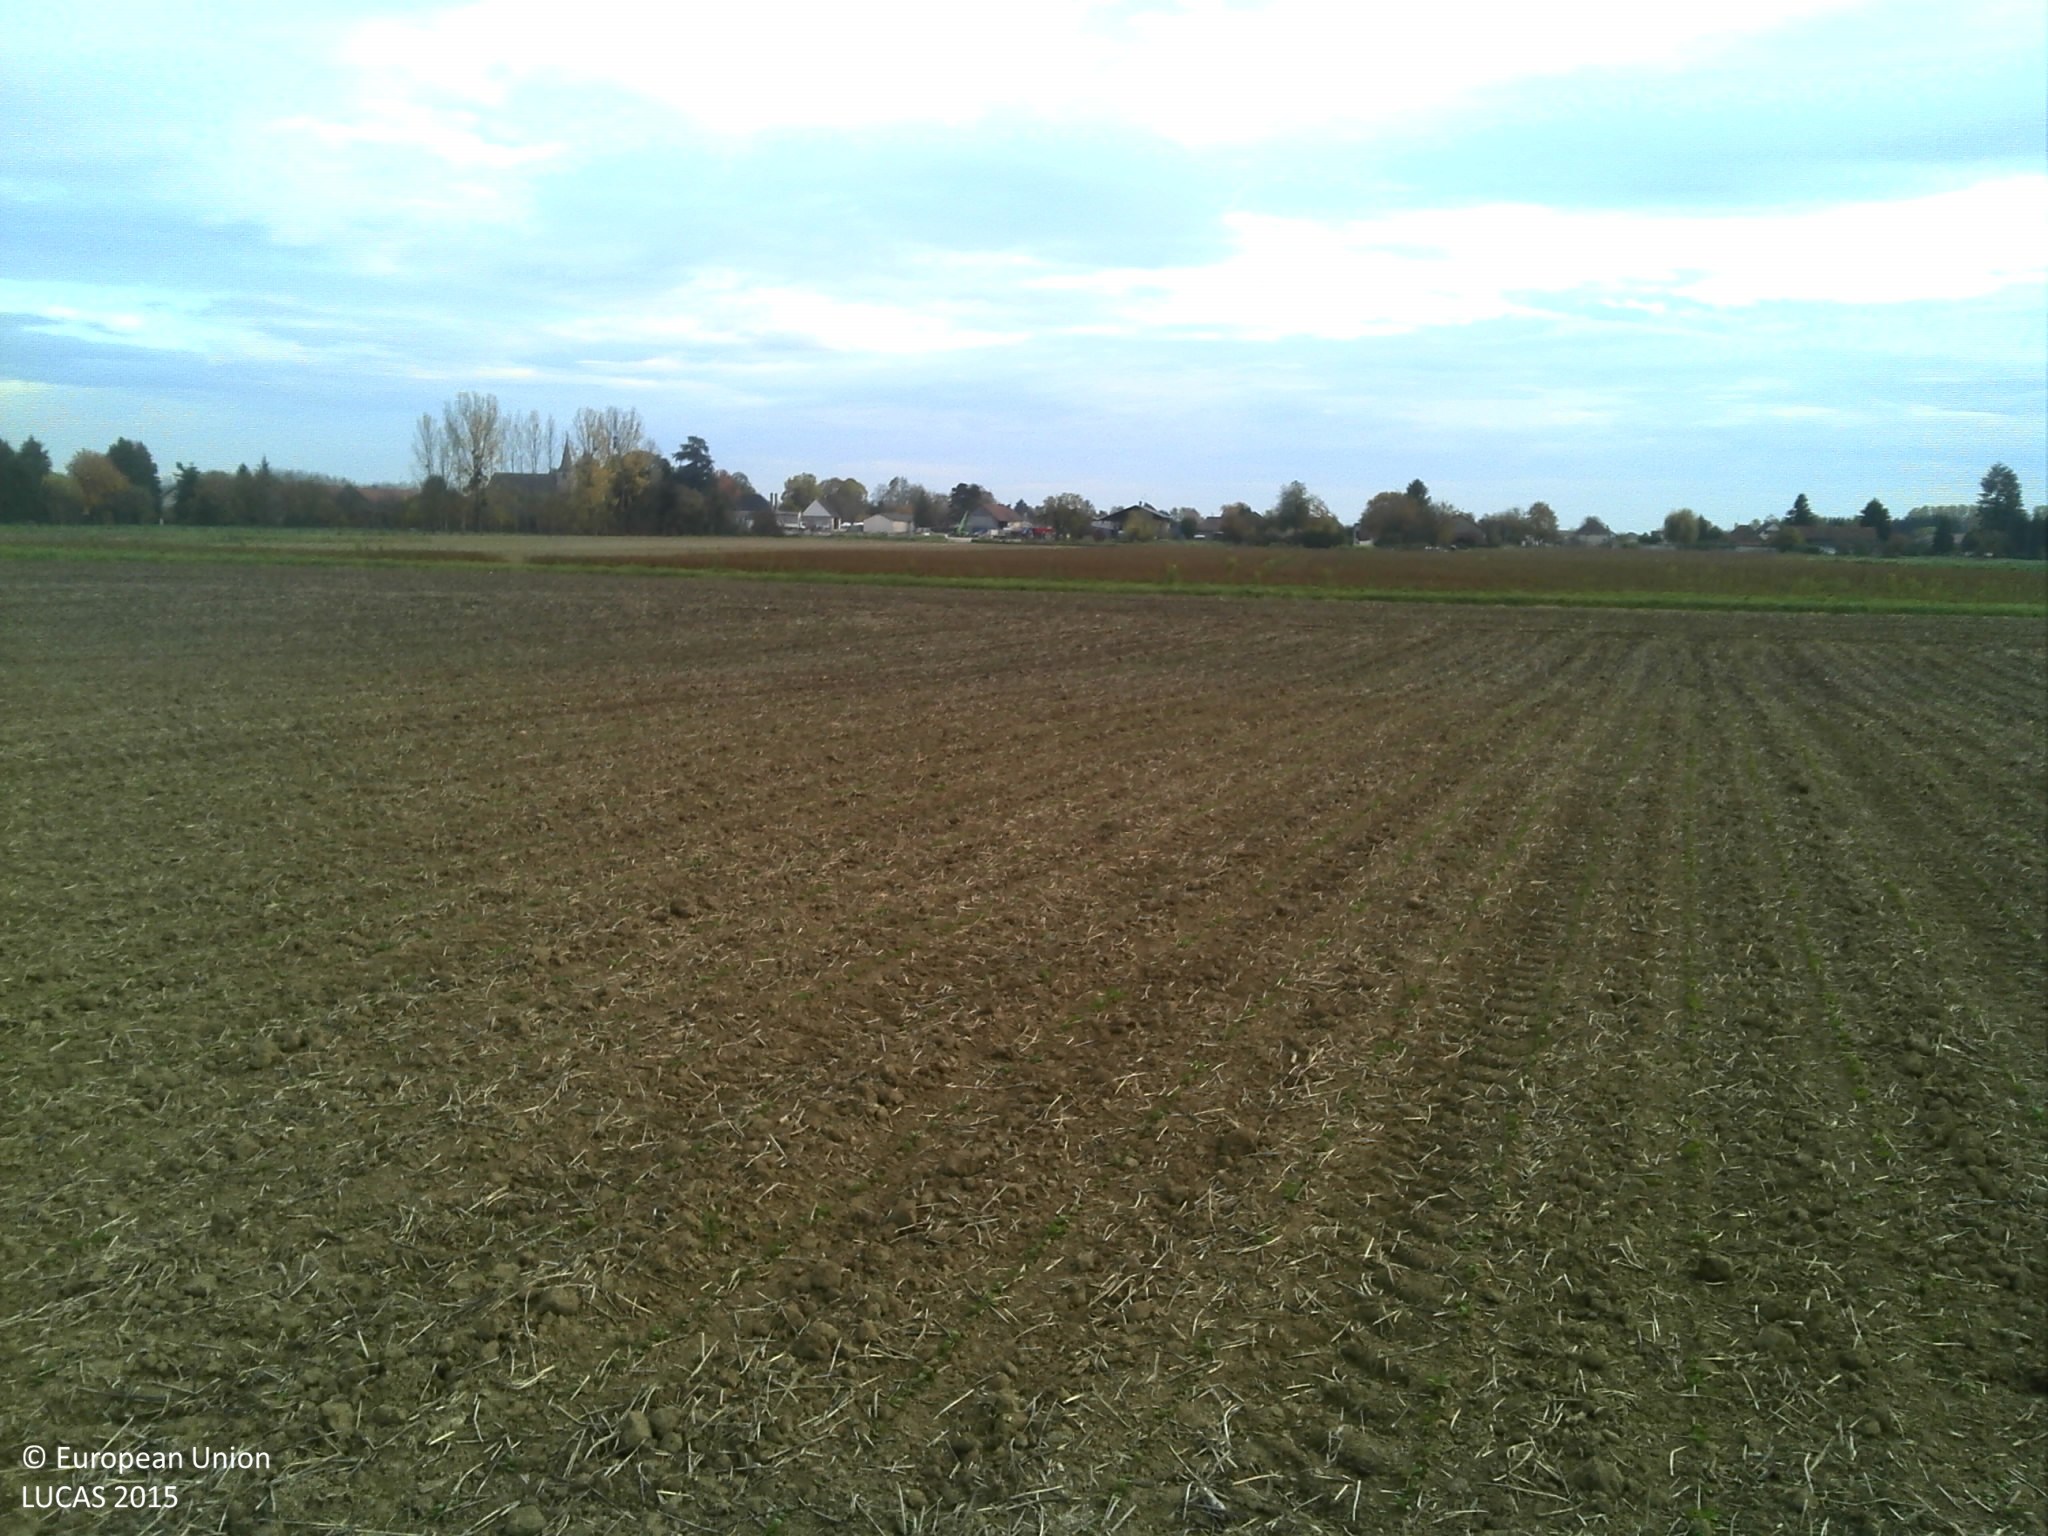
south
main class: Cropland
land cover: Other fibre and oleaginous crops
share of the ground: < 10 %
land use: Agriculture (excluding fallow land and kitchen gardens)
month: October
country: FR
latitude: 47.0585
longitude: 5.2749
